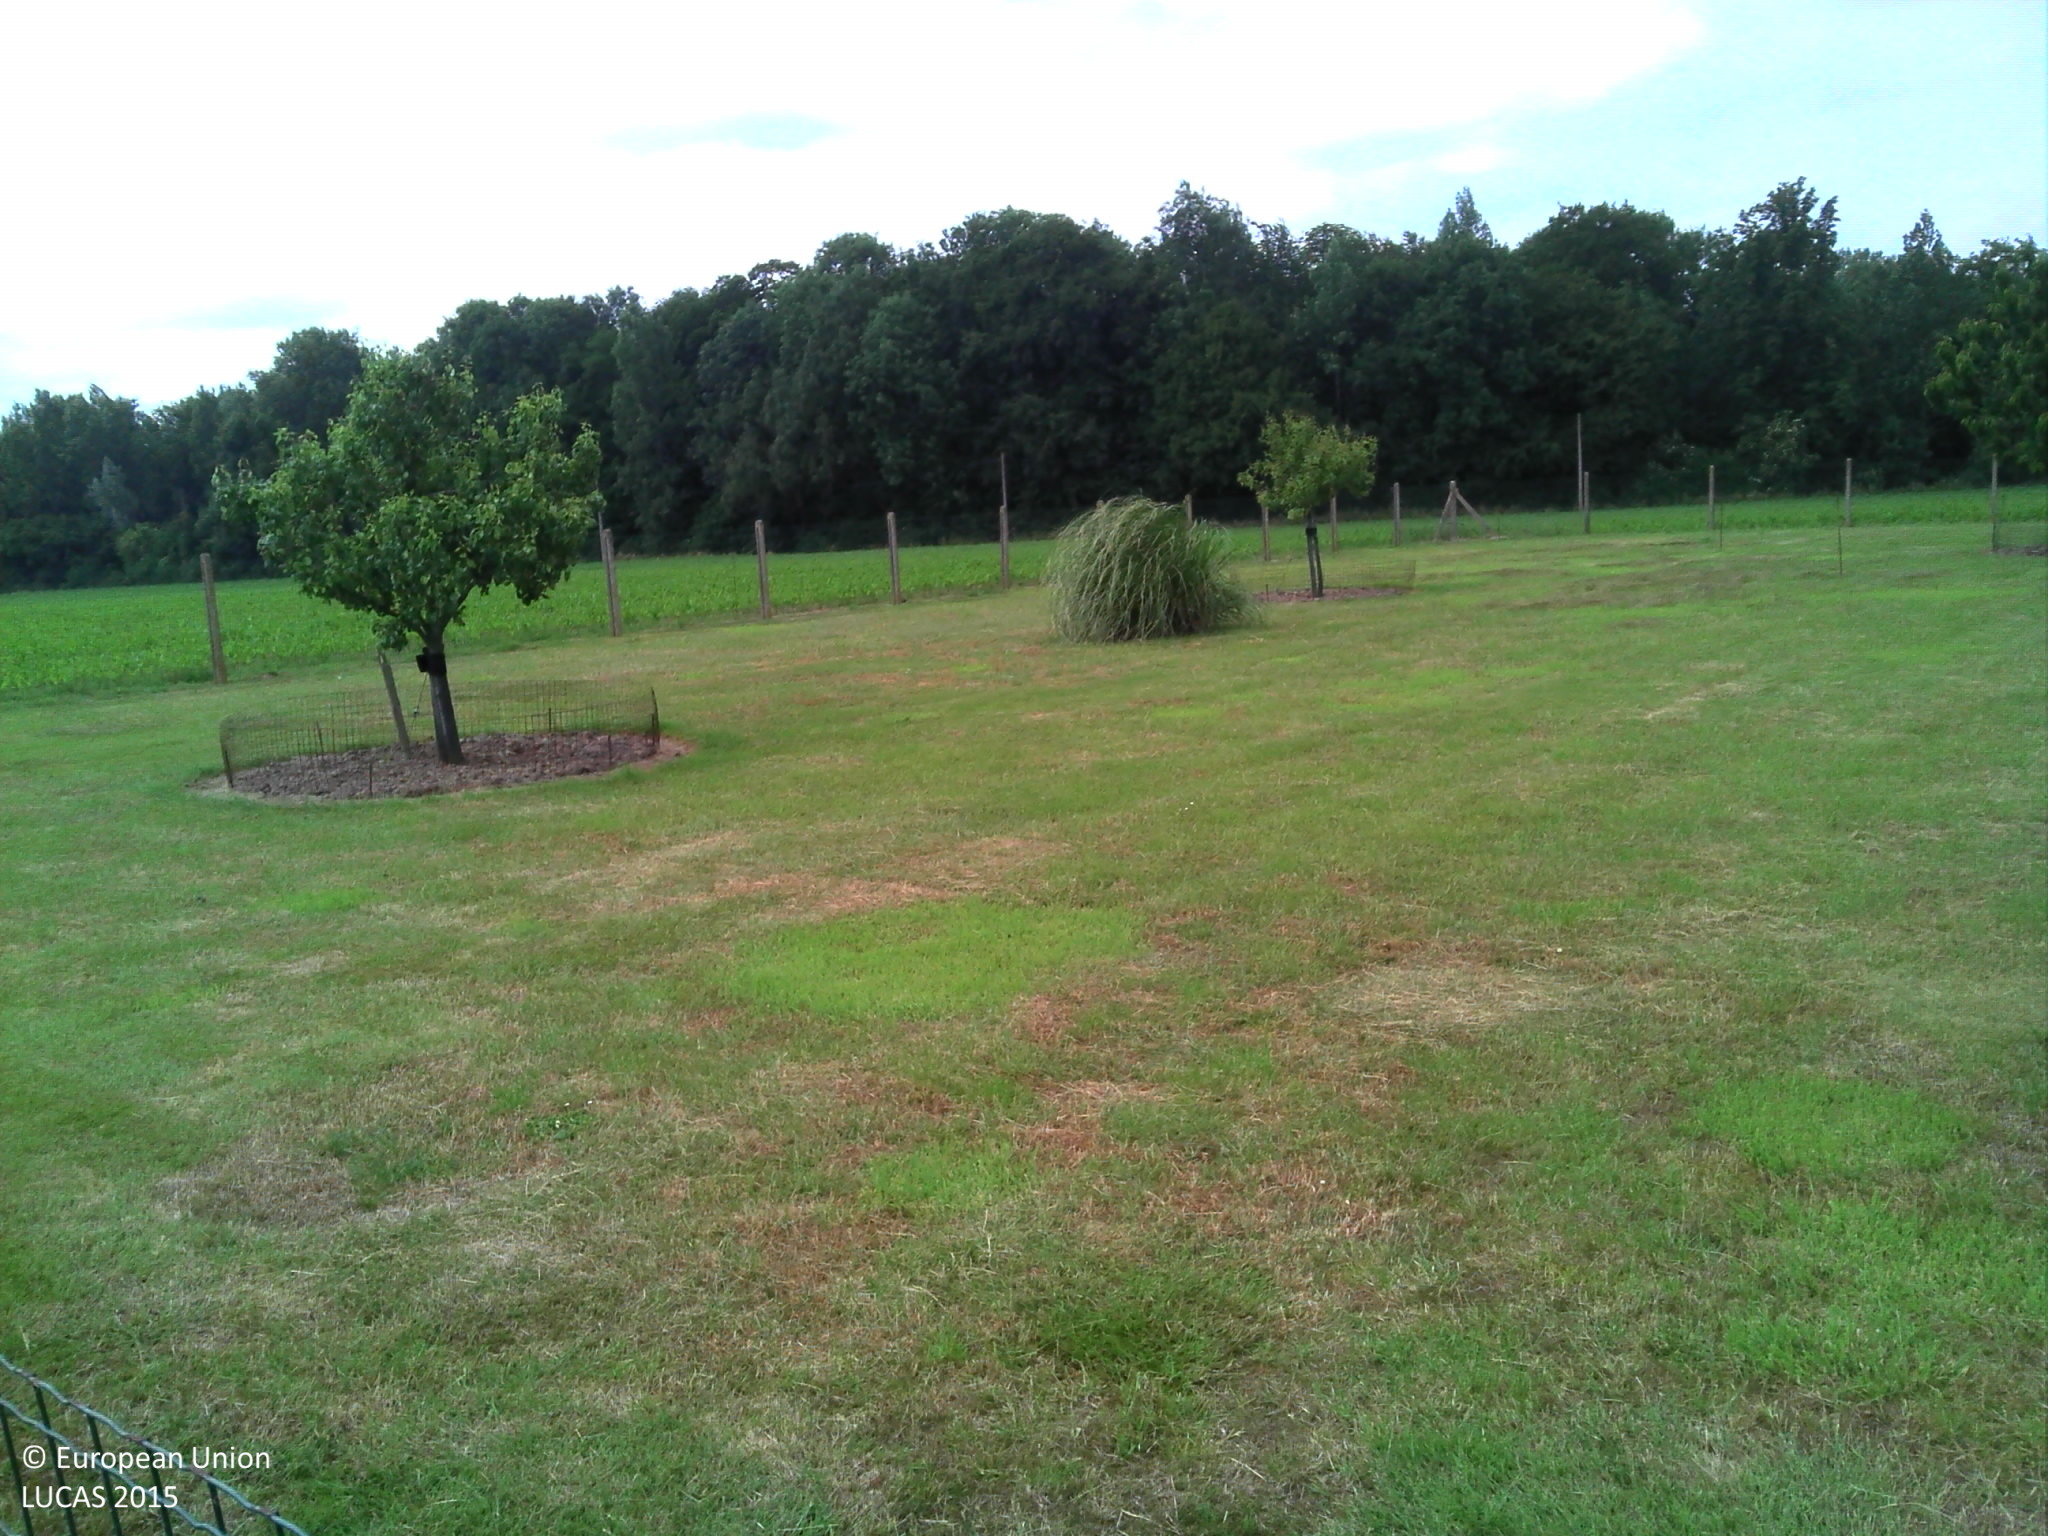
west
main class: Grassland
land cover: Grassland with sparse tree/shrub cover
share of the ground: > 75 %
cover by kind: herbaceous plants 95 %, broadleaved forest trees 5 %
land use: Residential
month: June
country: BE
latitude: 50.3876
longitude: 3.6779
